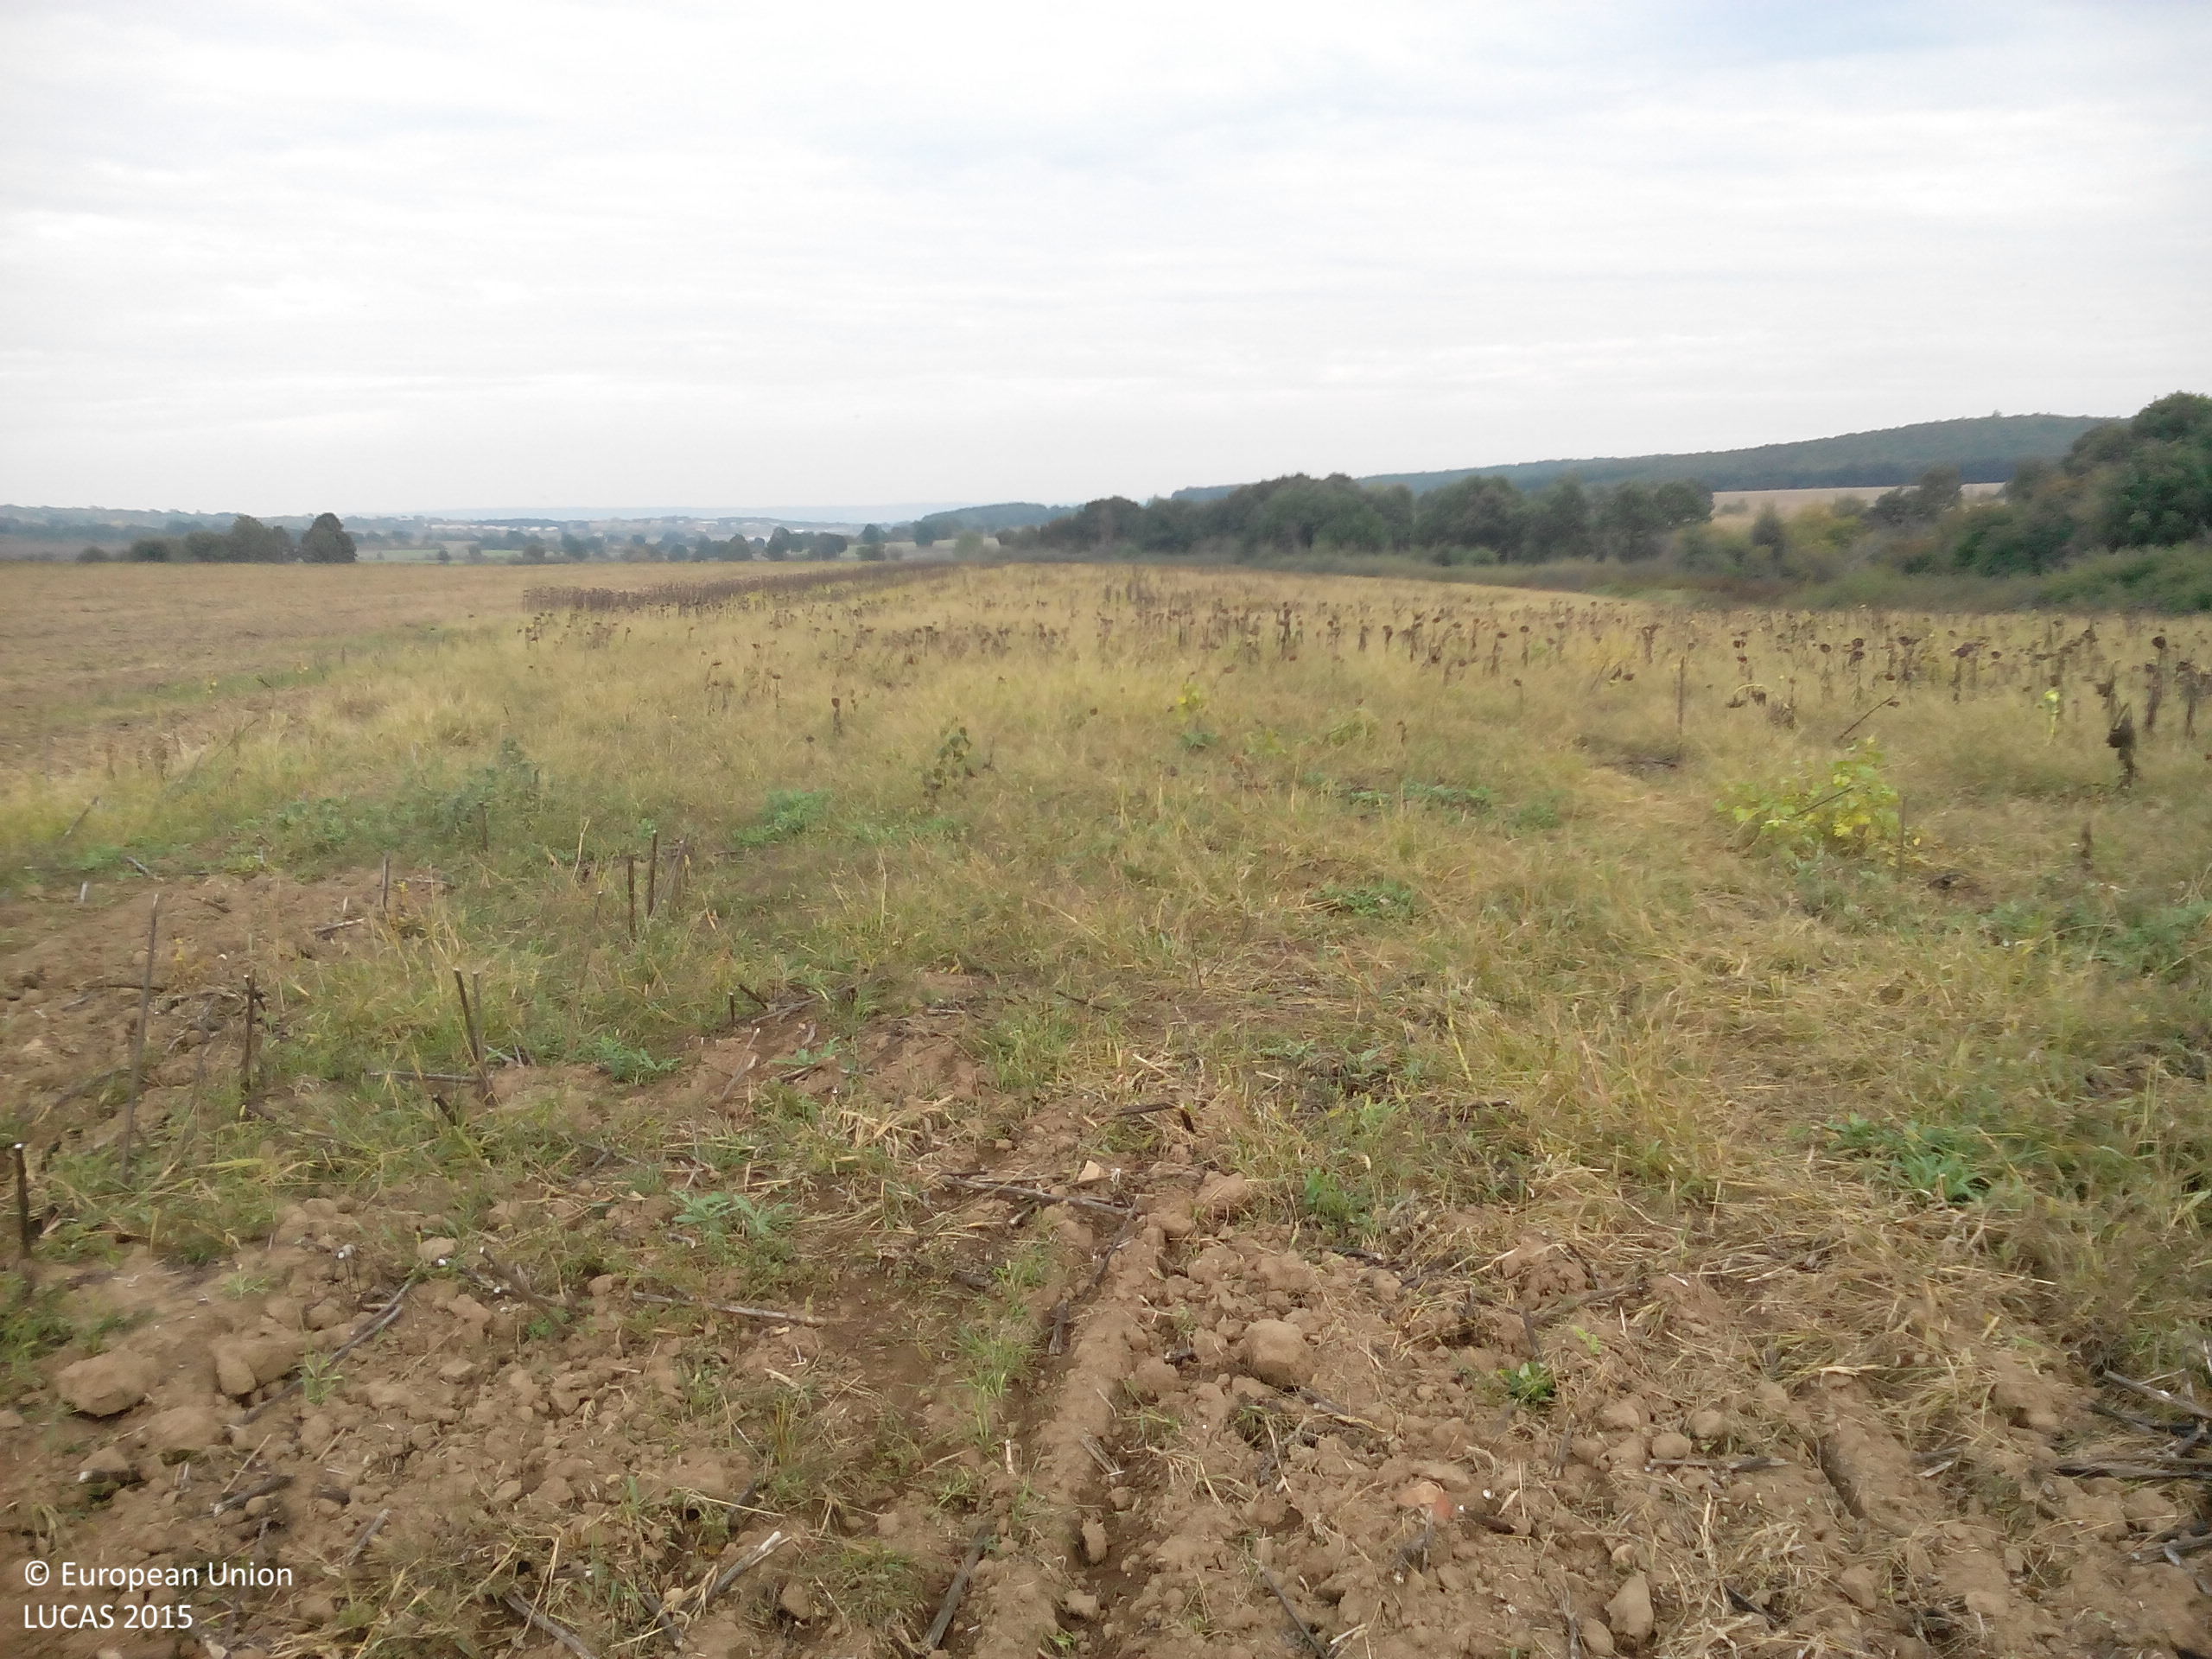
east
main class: Cropland
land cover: Sunflower
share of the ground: < 10 %
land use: Agriculture (excluding fallow land and kitchen gardens)
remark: Harvested field
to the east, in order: Sunflower
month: October
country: BG
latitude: 43.3019
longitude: 23.6169
